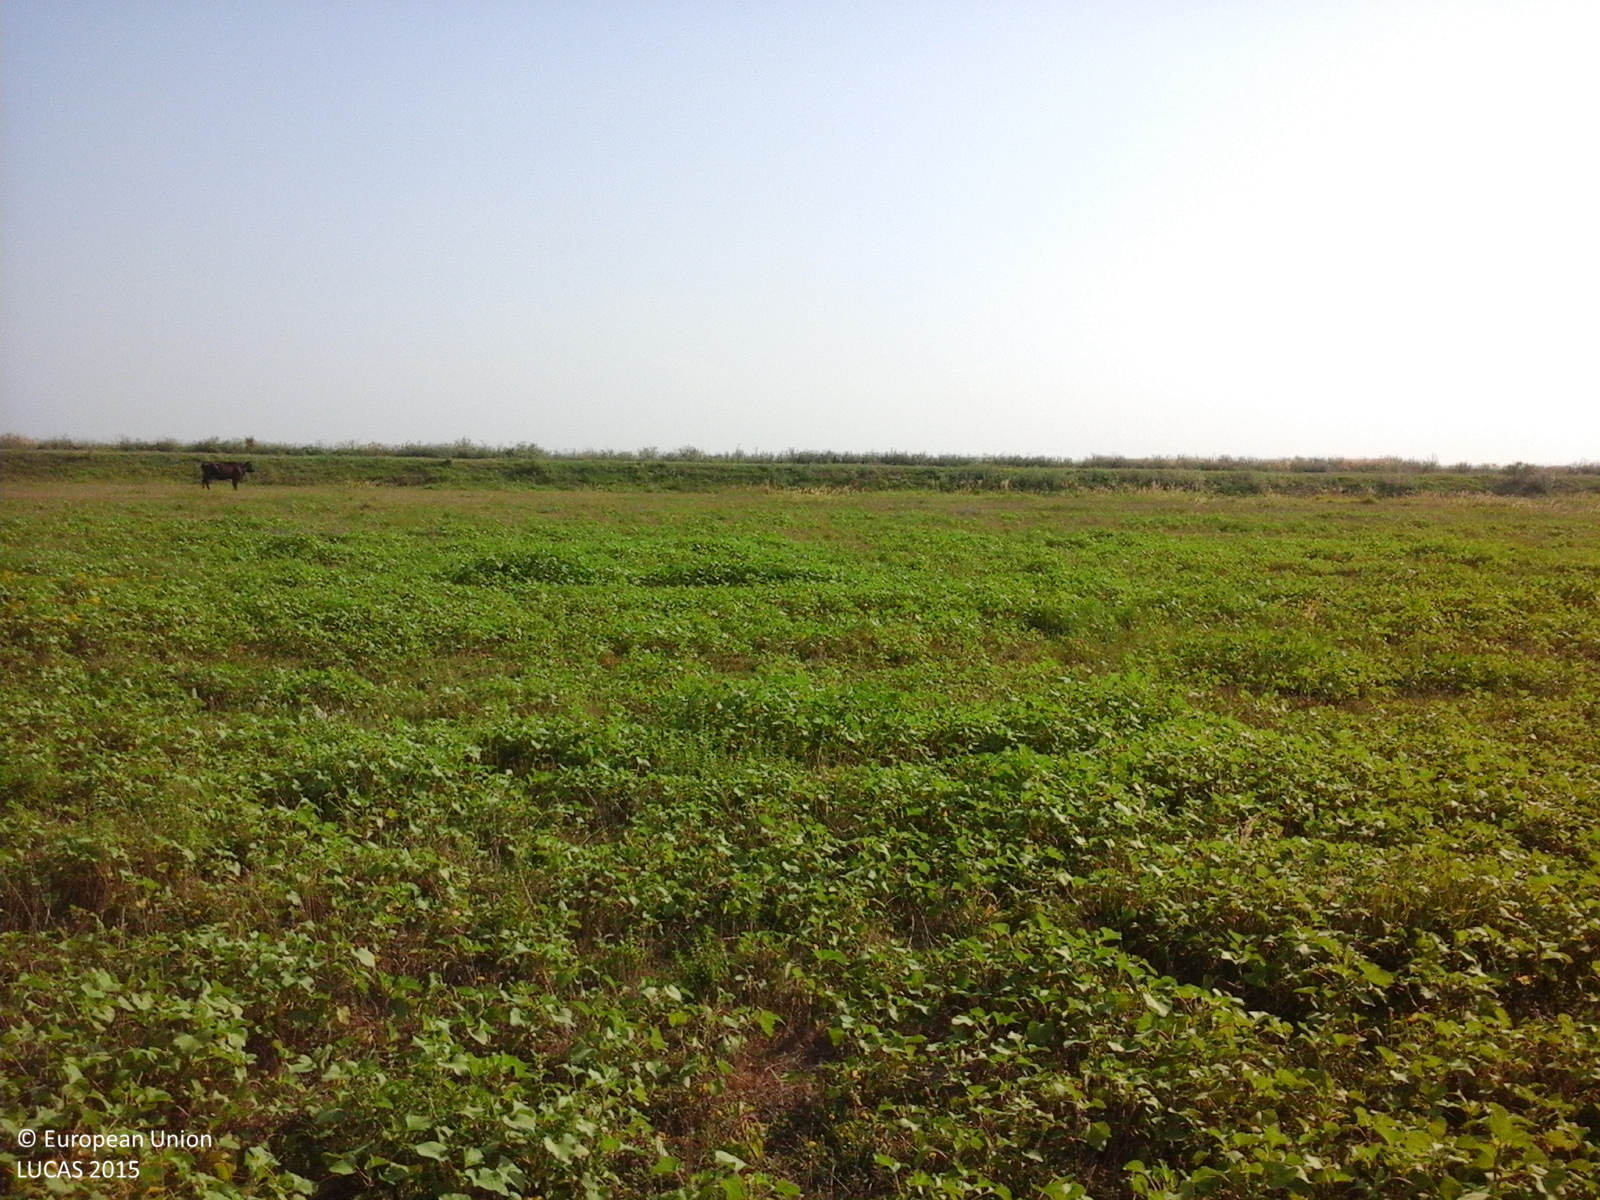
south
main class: Grassland
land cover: Spontaneously vegetated surfaces
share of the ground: > 75 %
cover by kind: herbaceous plants 100 %
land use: Agriculture (excluding fallow land and kitchen gardens)
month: August
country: RO
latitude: 43.8751
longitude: 23.7032
